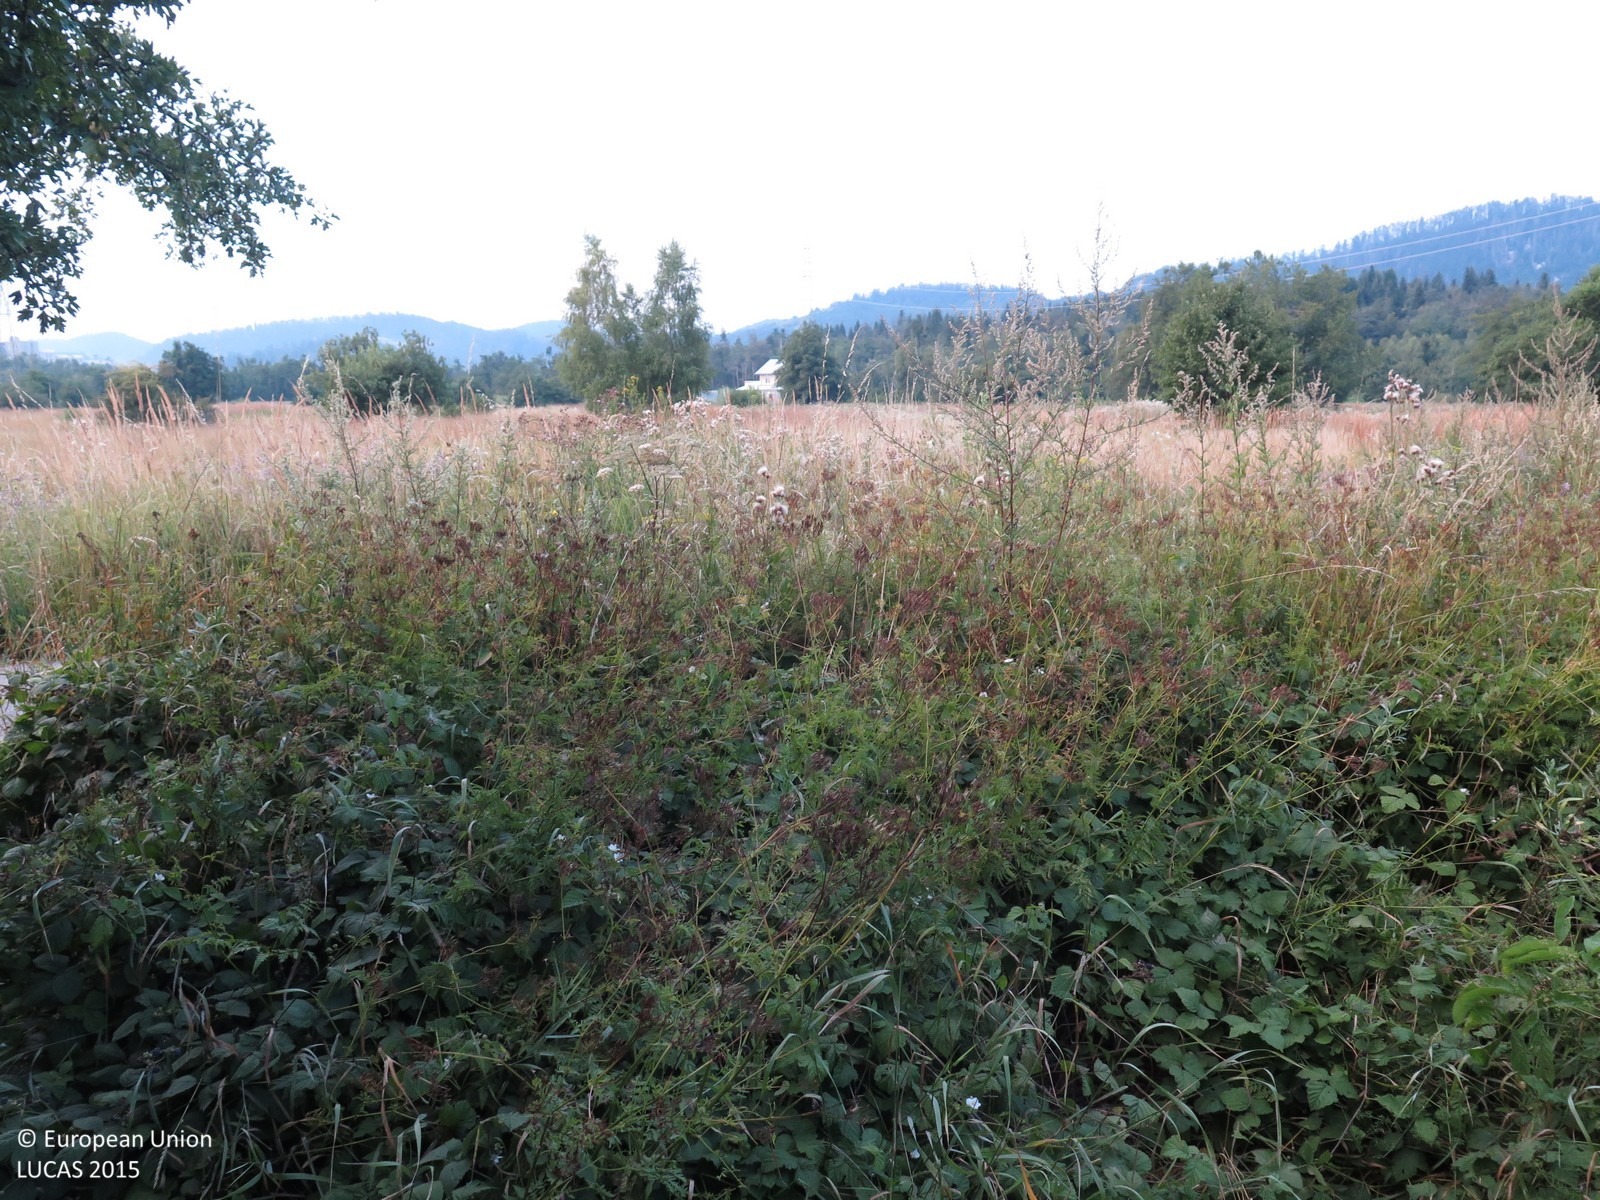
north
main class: Shrubland
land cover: Shrubland with sparse tree cover
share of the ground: > 75 %
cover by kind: shrubs 90 %, broadleaved forest trees 5 %, herbaceous plants 5 %
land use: Semi-natural and natural areas not in use
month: August
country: HR
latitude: 45.2903
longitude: 14.7254
